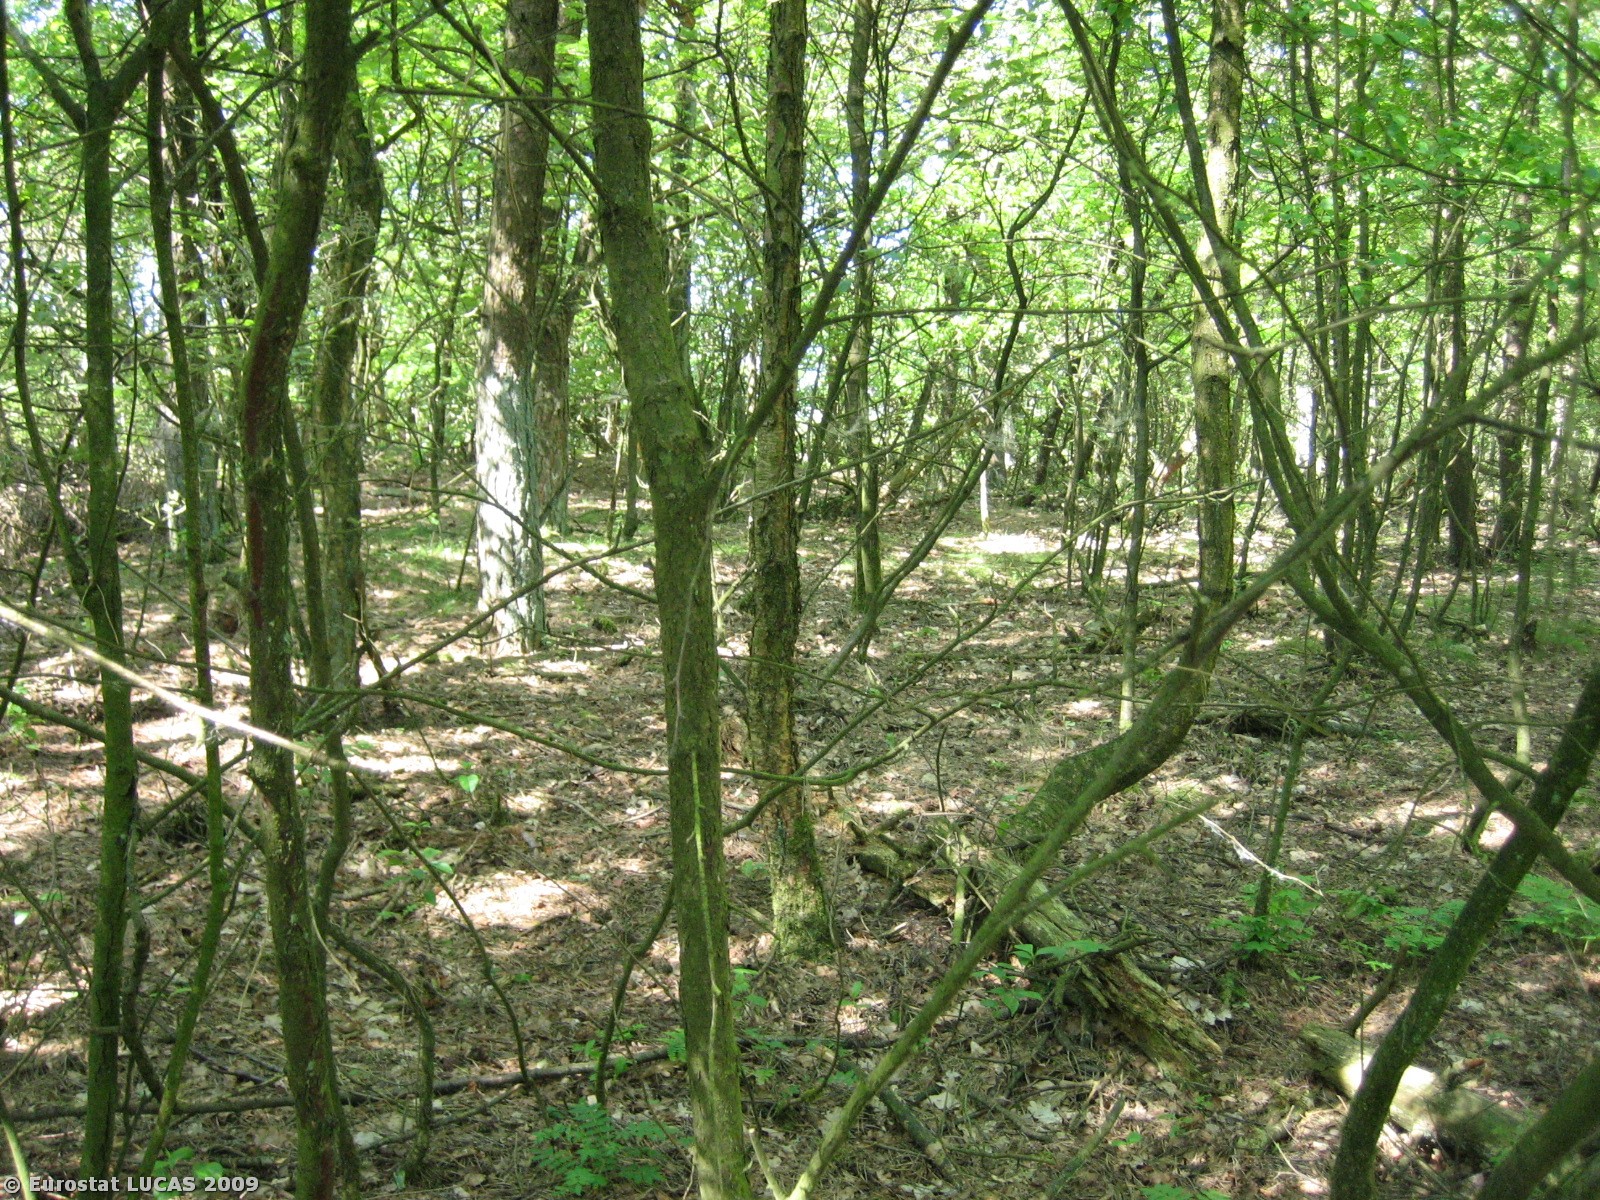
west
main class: Woodland
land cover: Mixed woodland
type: mesophytic deciduous forest
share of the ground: > 75 %
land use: Unused
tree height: > 5 m
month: May
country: DK
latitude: 55.9139
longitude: 8.9612
